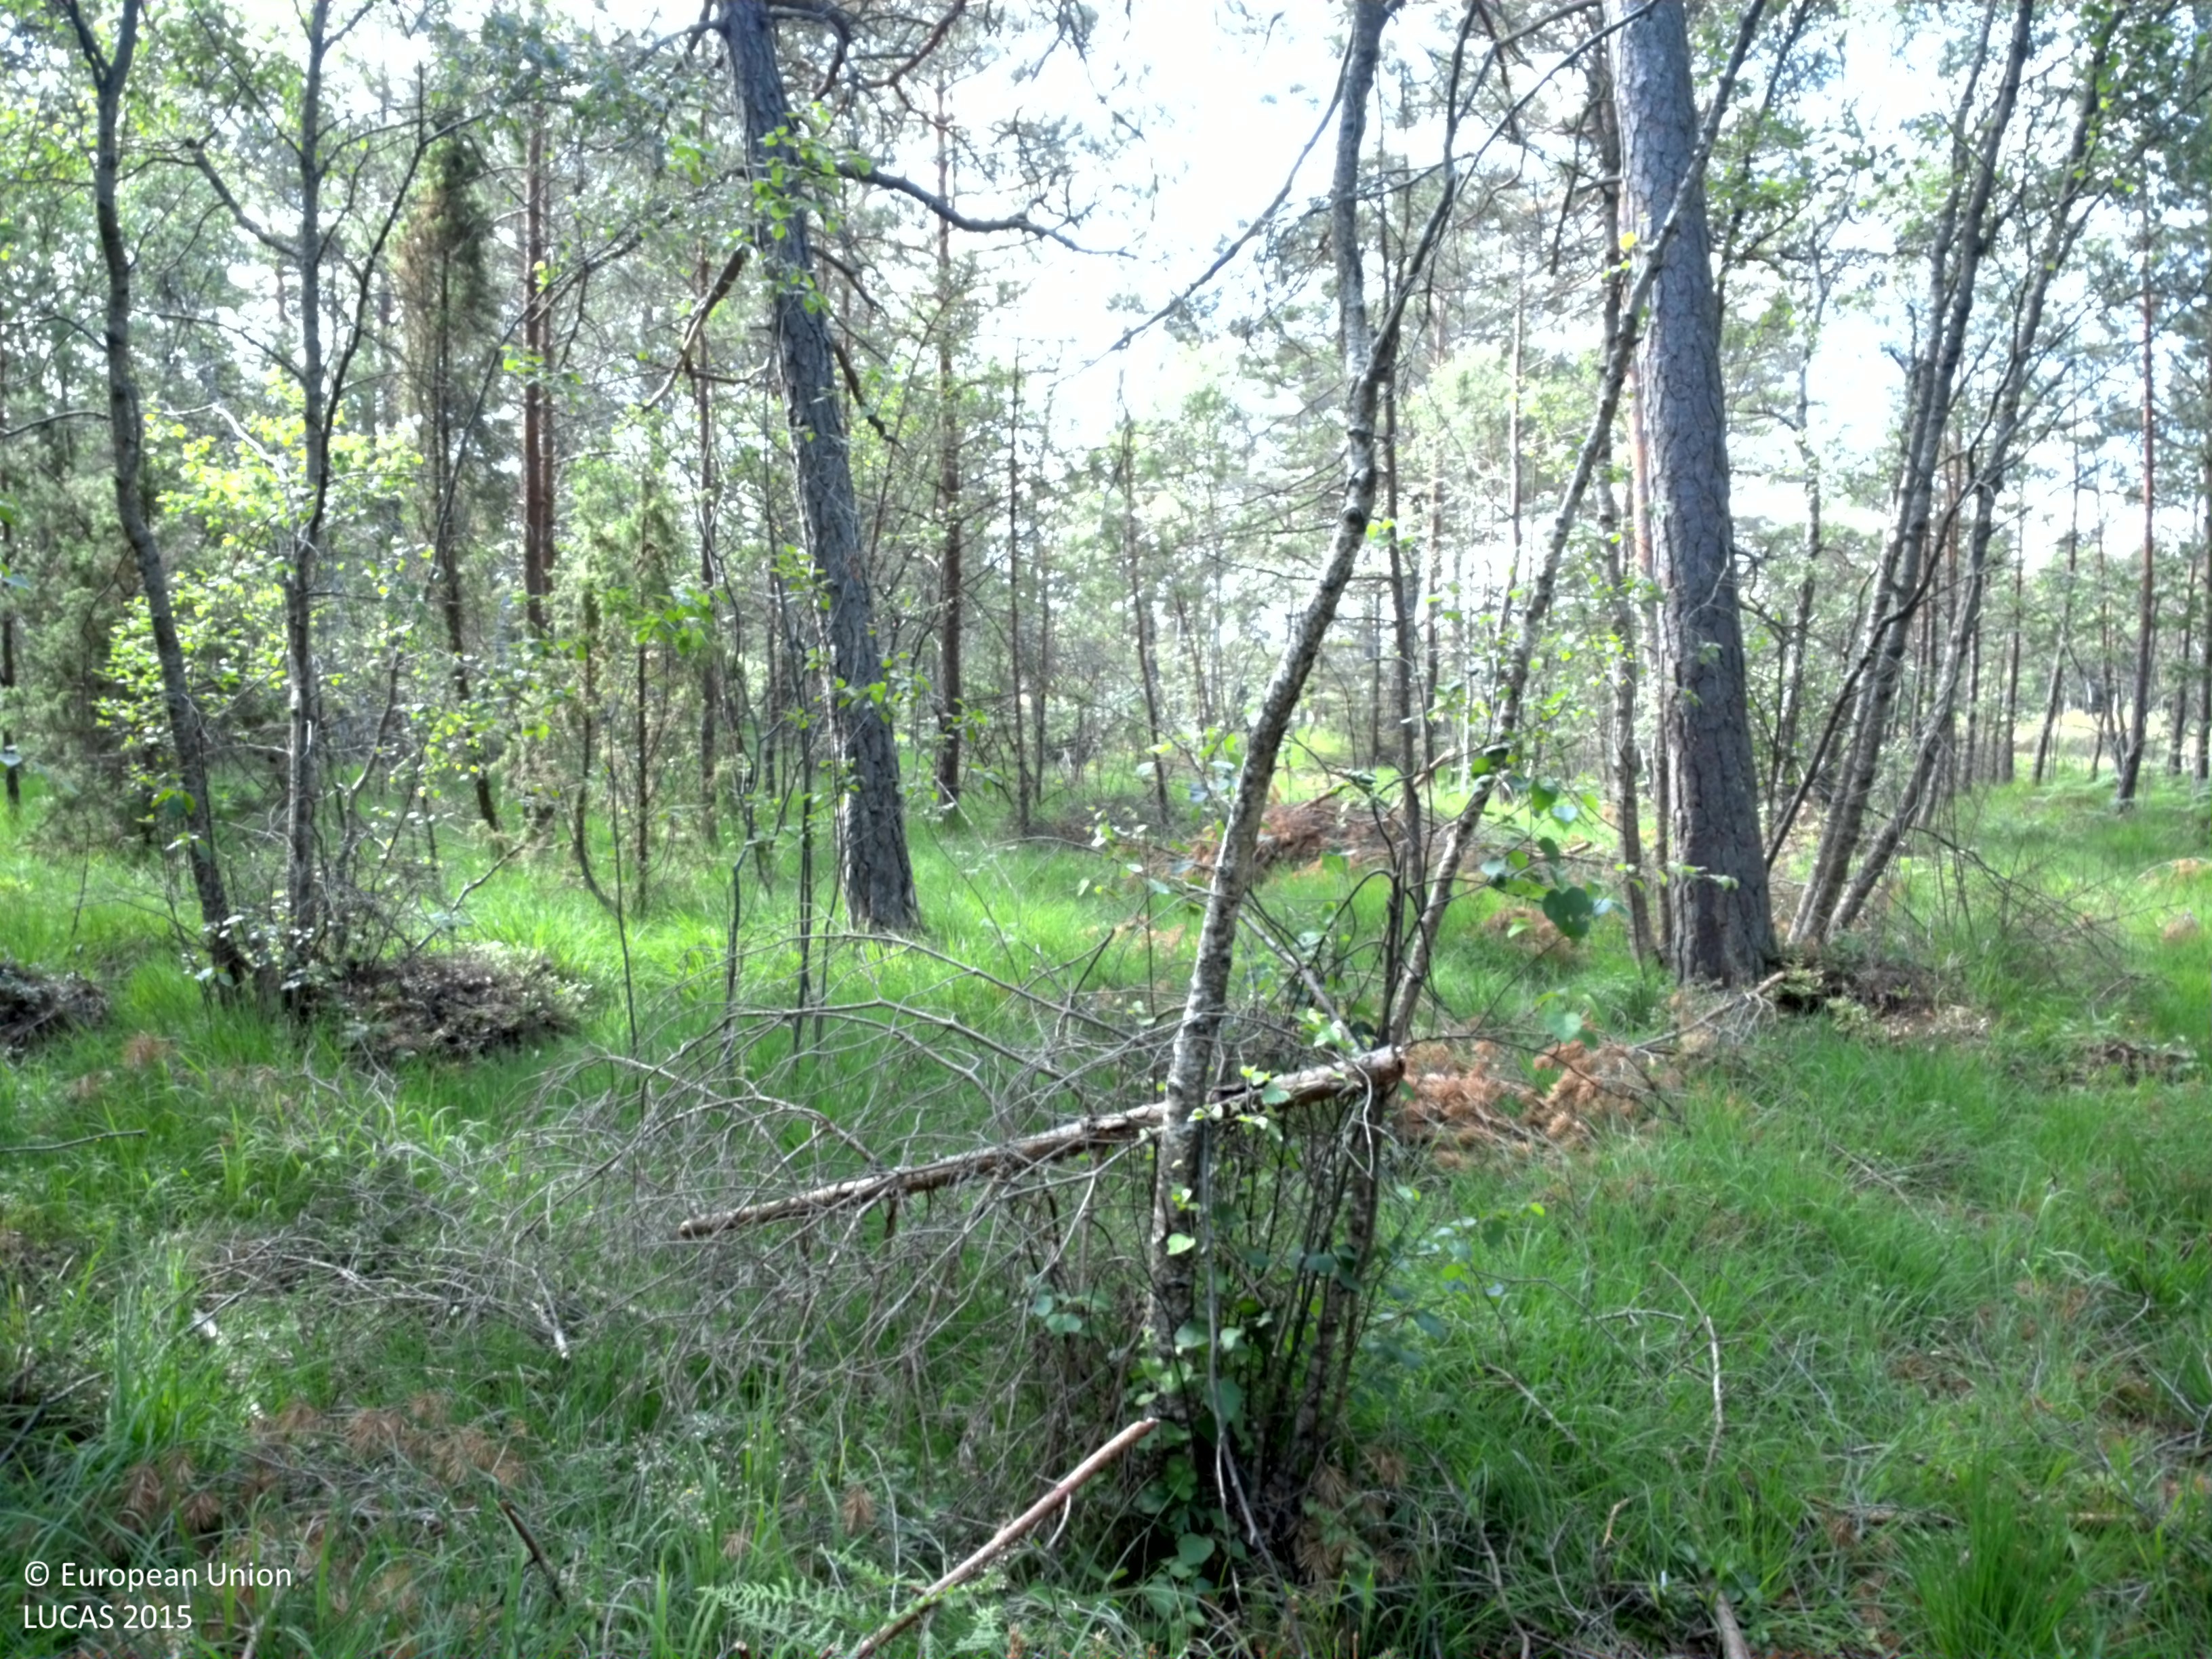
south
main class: Woodland
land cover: Pine dominated mixed woodland
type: hemiboreal forest and nemoral coniferous forest and mixed broadleaved-coniferous forest
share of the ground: 50 - 75 %
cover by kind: herbaceous plants 40 %, coniferous forest trees 35 %, broadleaved forest trees 20 %, shrubs 5 %
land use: Forestry
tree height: > 5 m
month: July
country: SE
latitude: 57.3932
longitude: 18.7125
